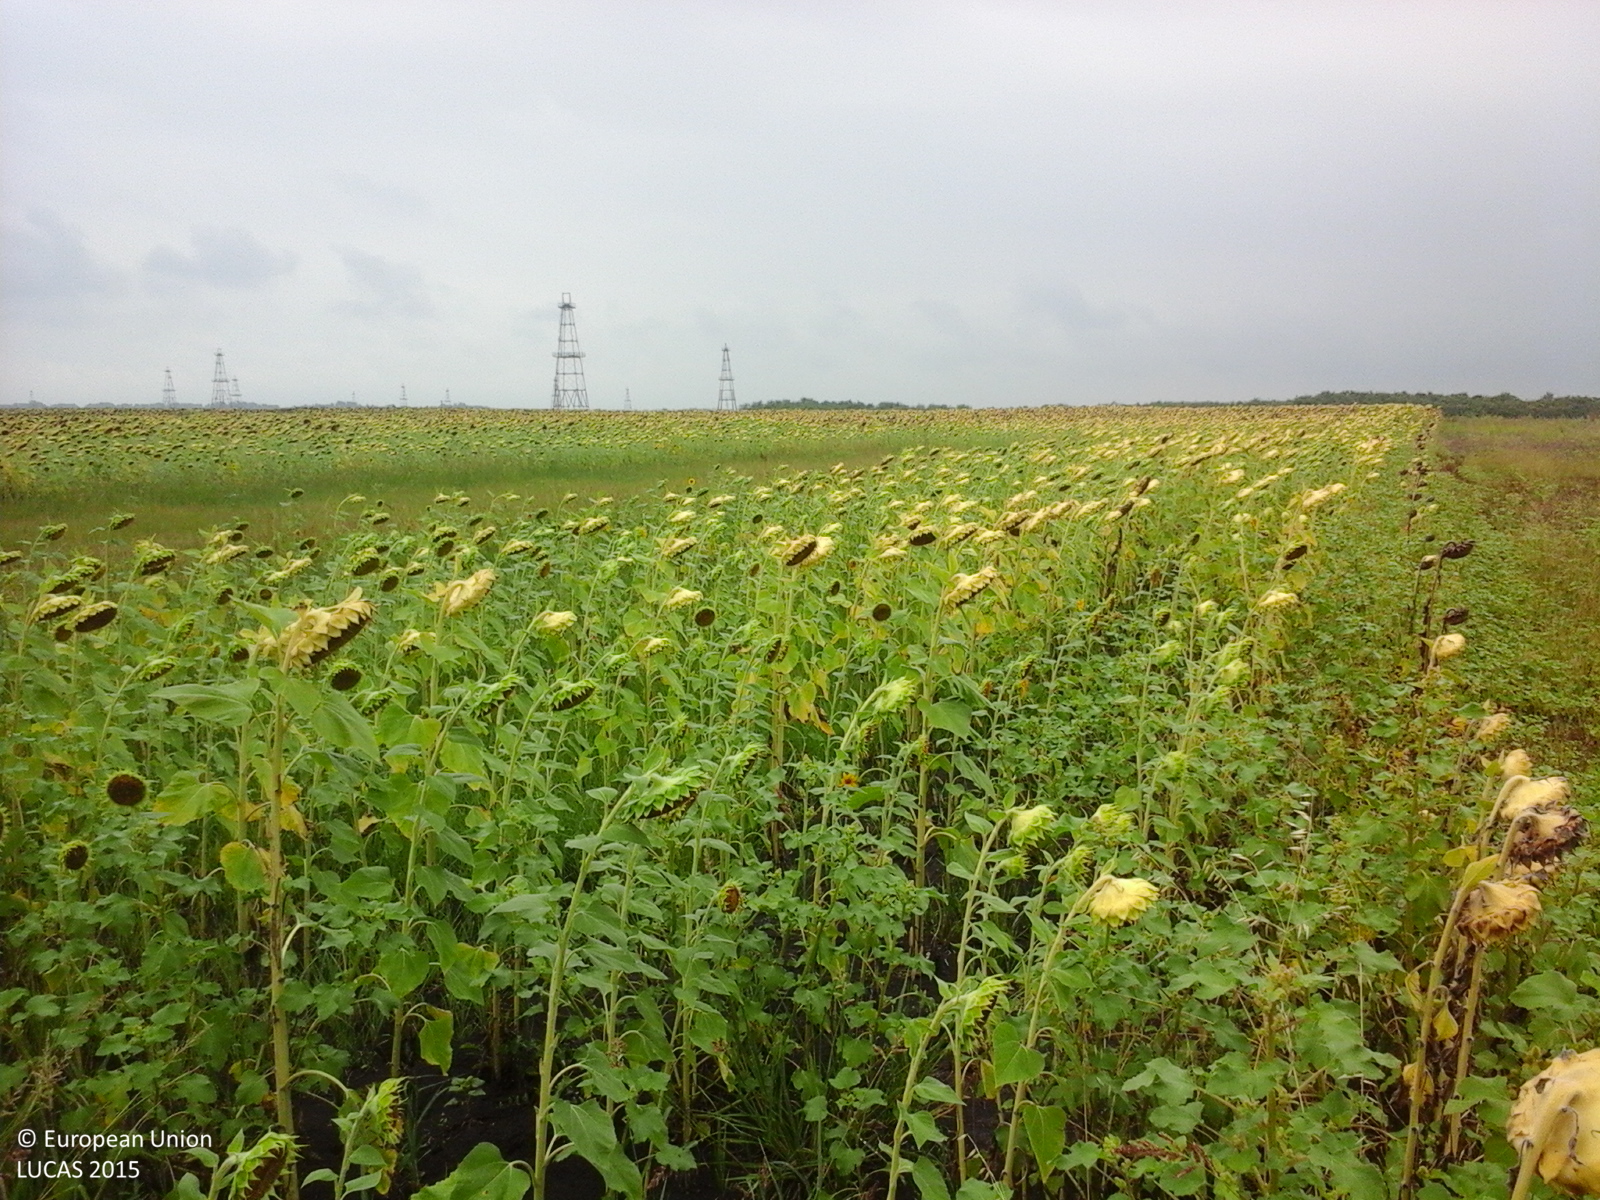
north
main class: Cropland
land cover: Sunflower
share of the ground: > 75 %
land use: Agriculture (excluding fallow land and kitchen gardens)
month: August
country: RO
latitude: 46.1316
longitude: 20.4173
